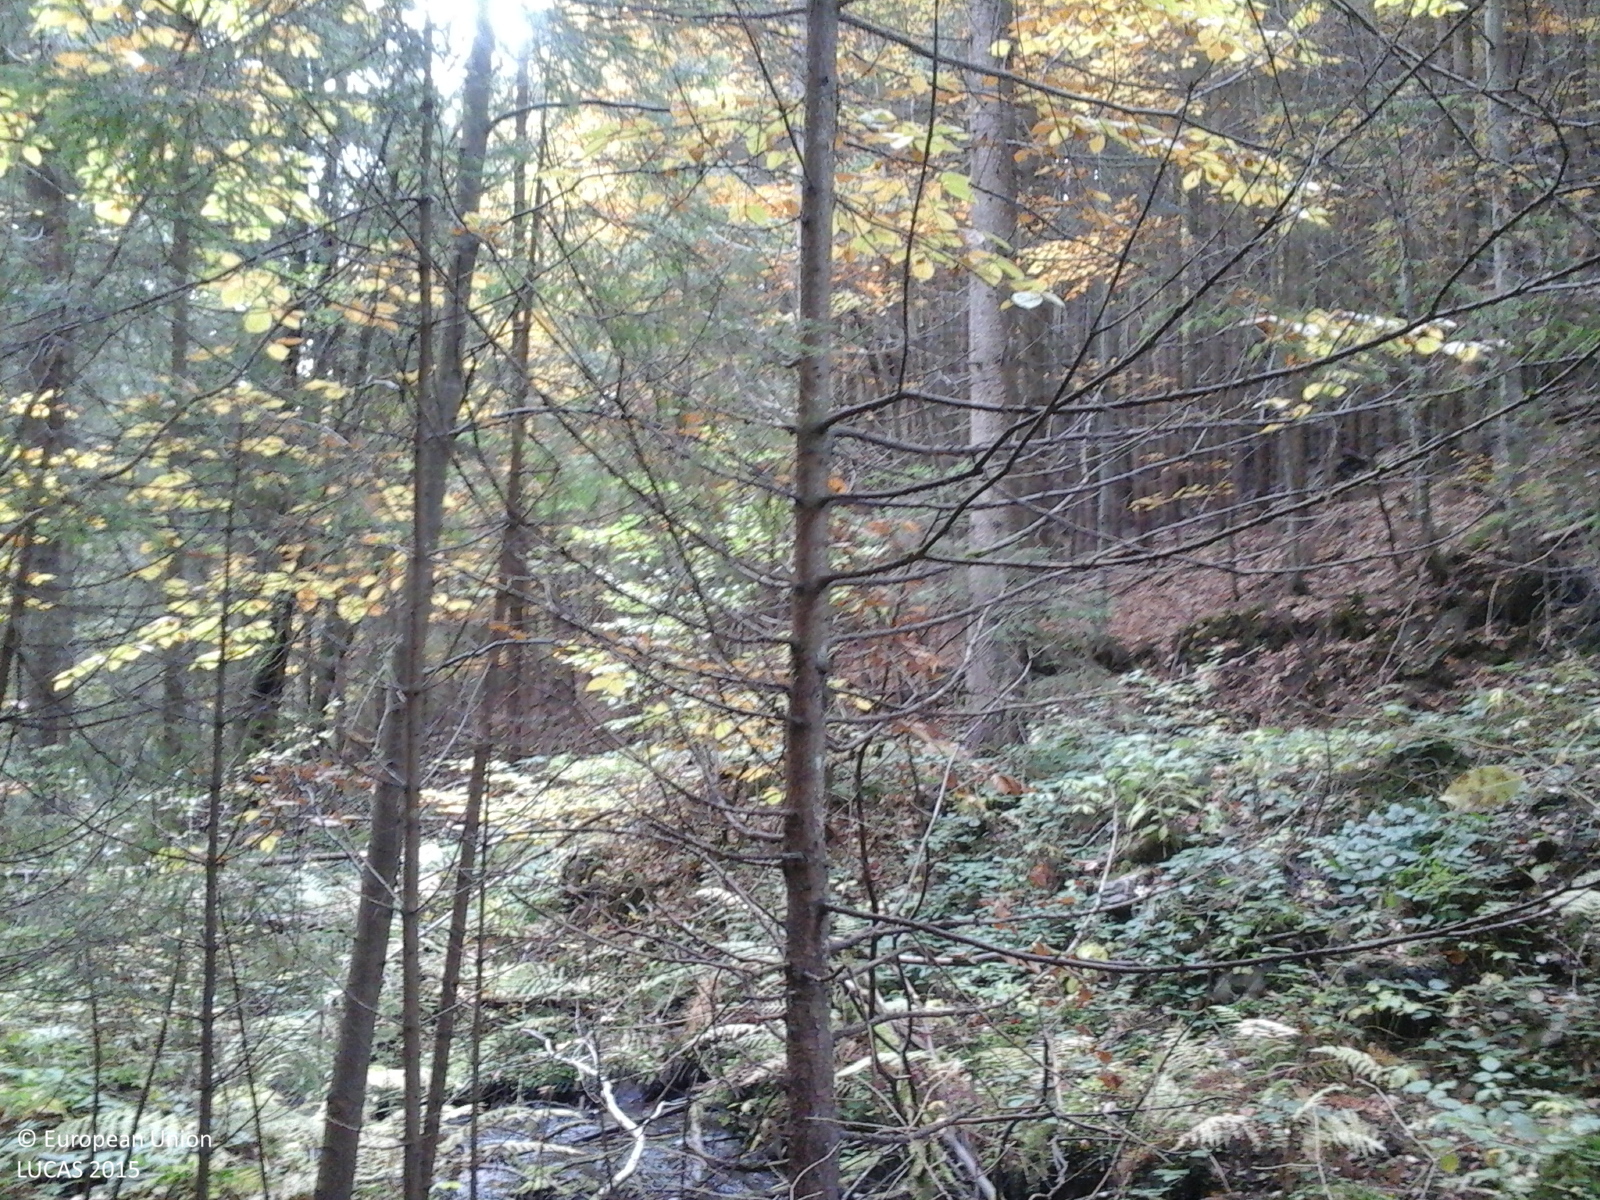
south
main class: Woodland
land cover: Spruce dominated mixed woodland
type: alpine coniferous forest
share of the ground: > 75 %
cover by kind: coniferous forest trees 60 %, broadleaved forest trees 40 %
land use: Forestry
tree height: > 5 m
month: October
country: RO
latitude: 46.5562
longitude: 25.4608
